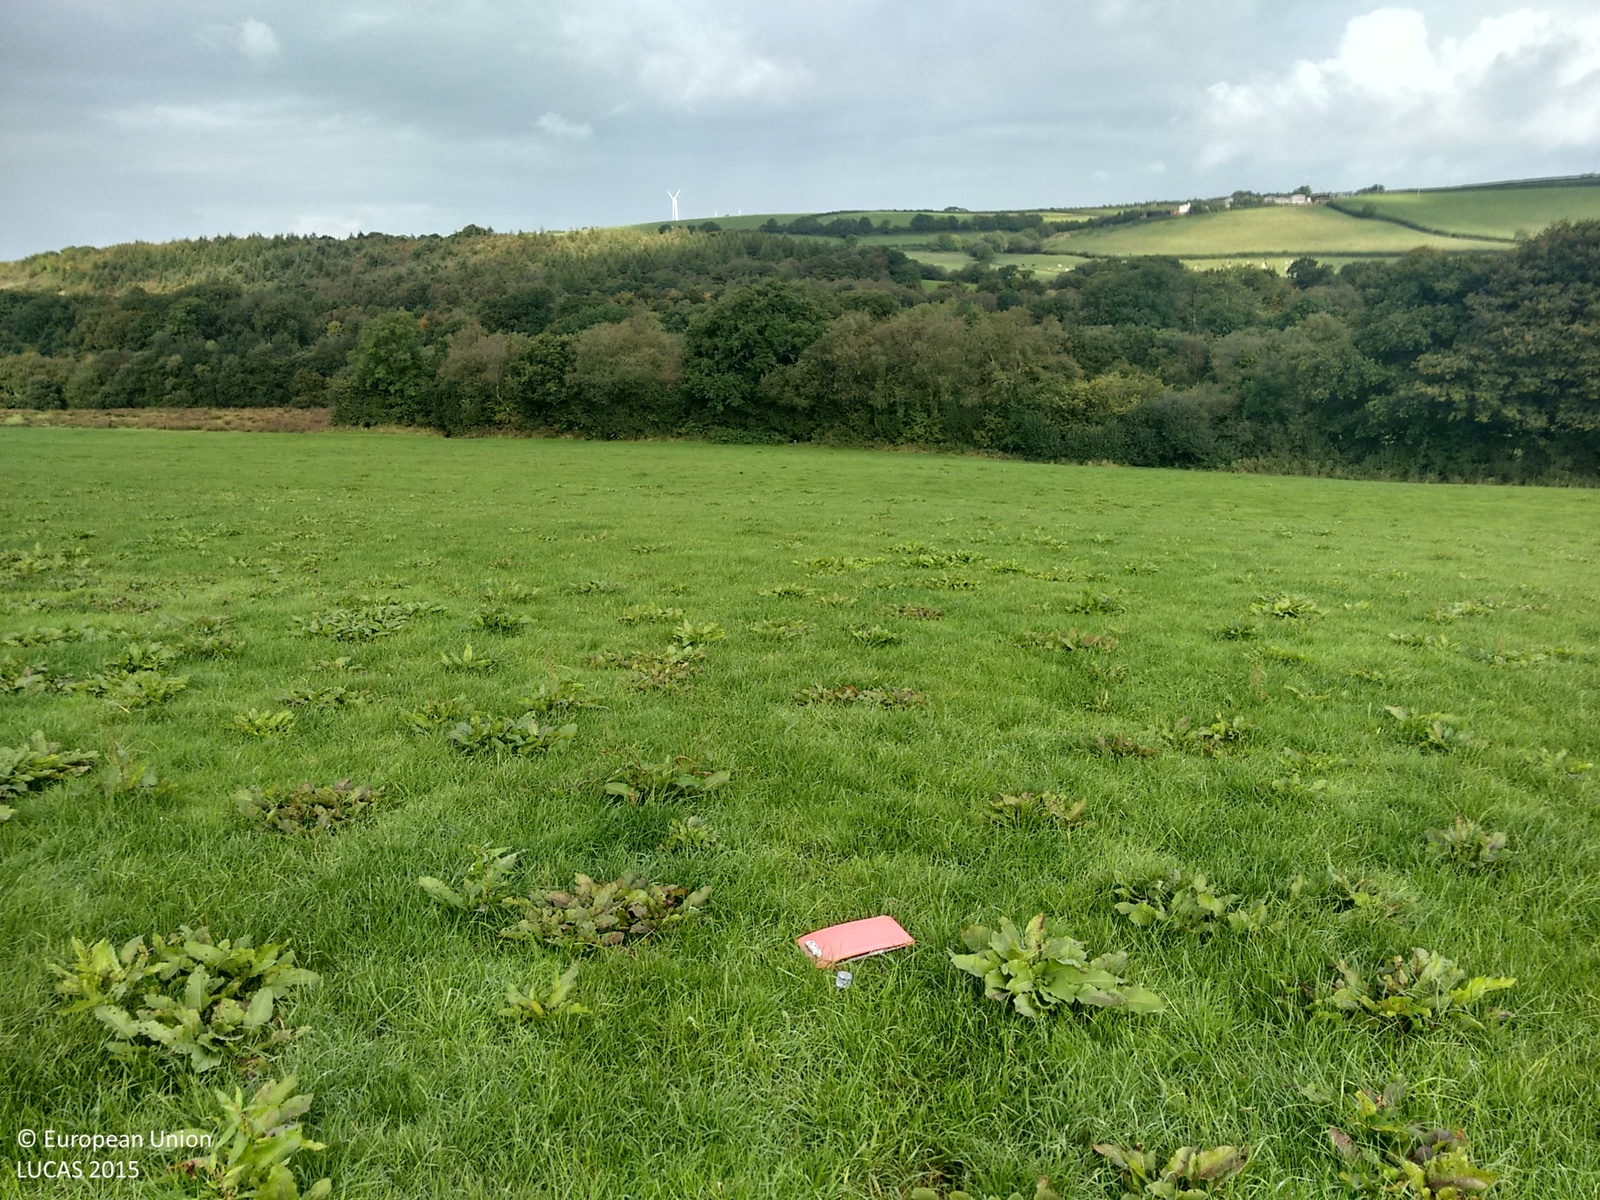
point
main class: Grassland
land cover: Grassland without tree/shrub cover
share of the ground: > 75 %
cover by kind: herbaceous plants 100 %
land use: Agriculture (excluding fallow land and kitchen gardens)
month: September
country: GB
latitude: 50.6768
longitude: -4.2072
